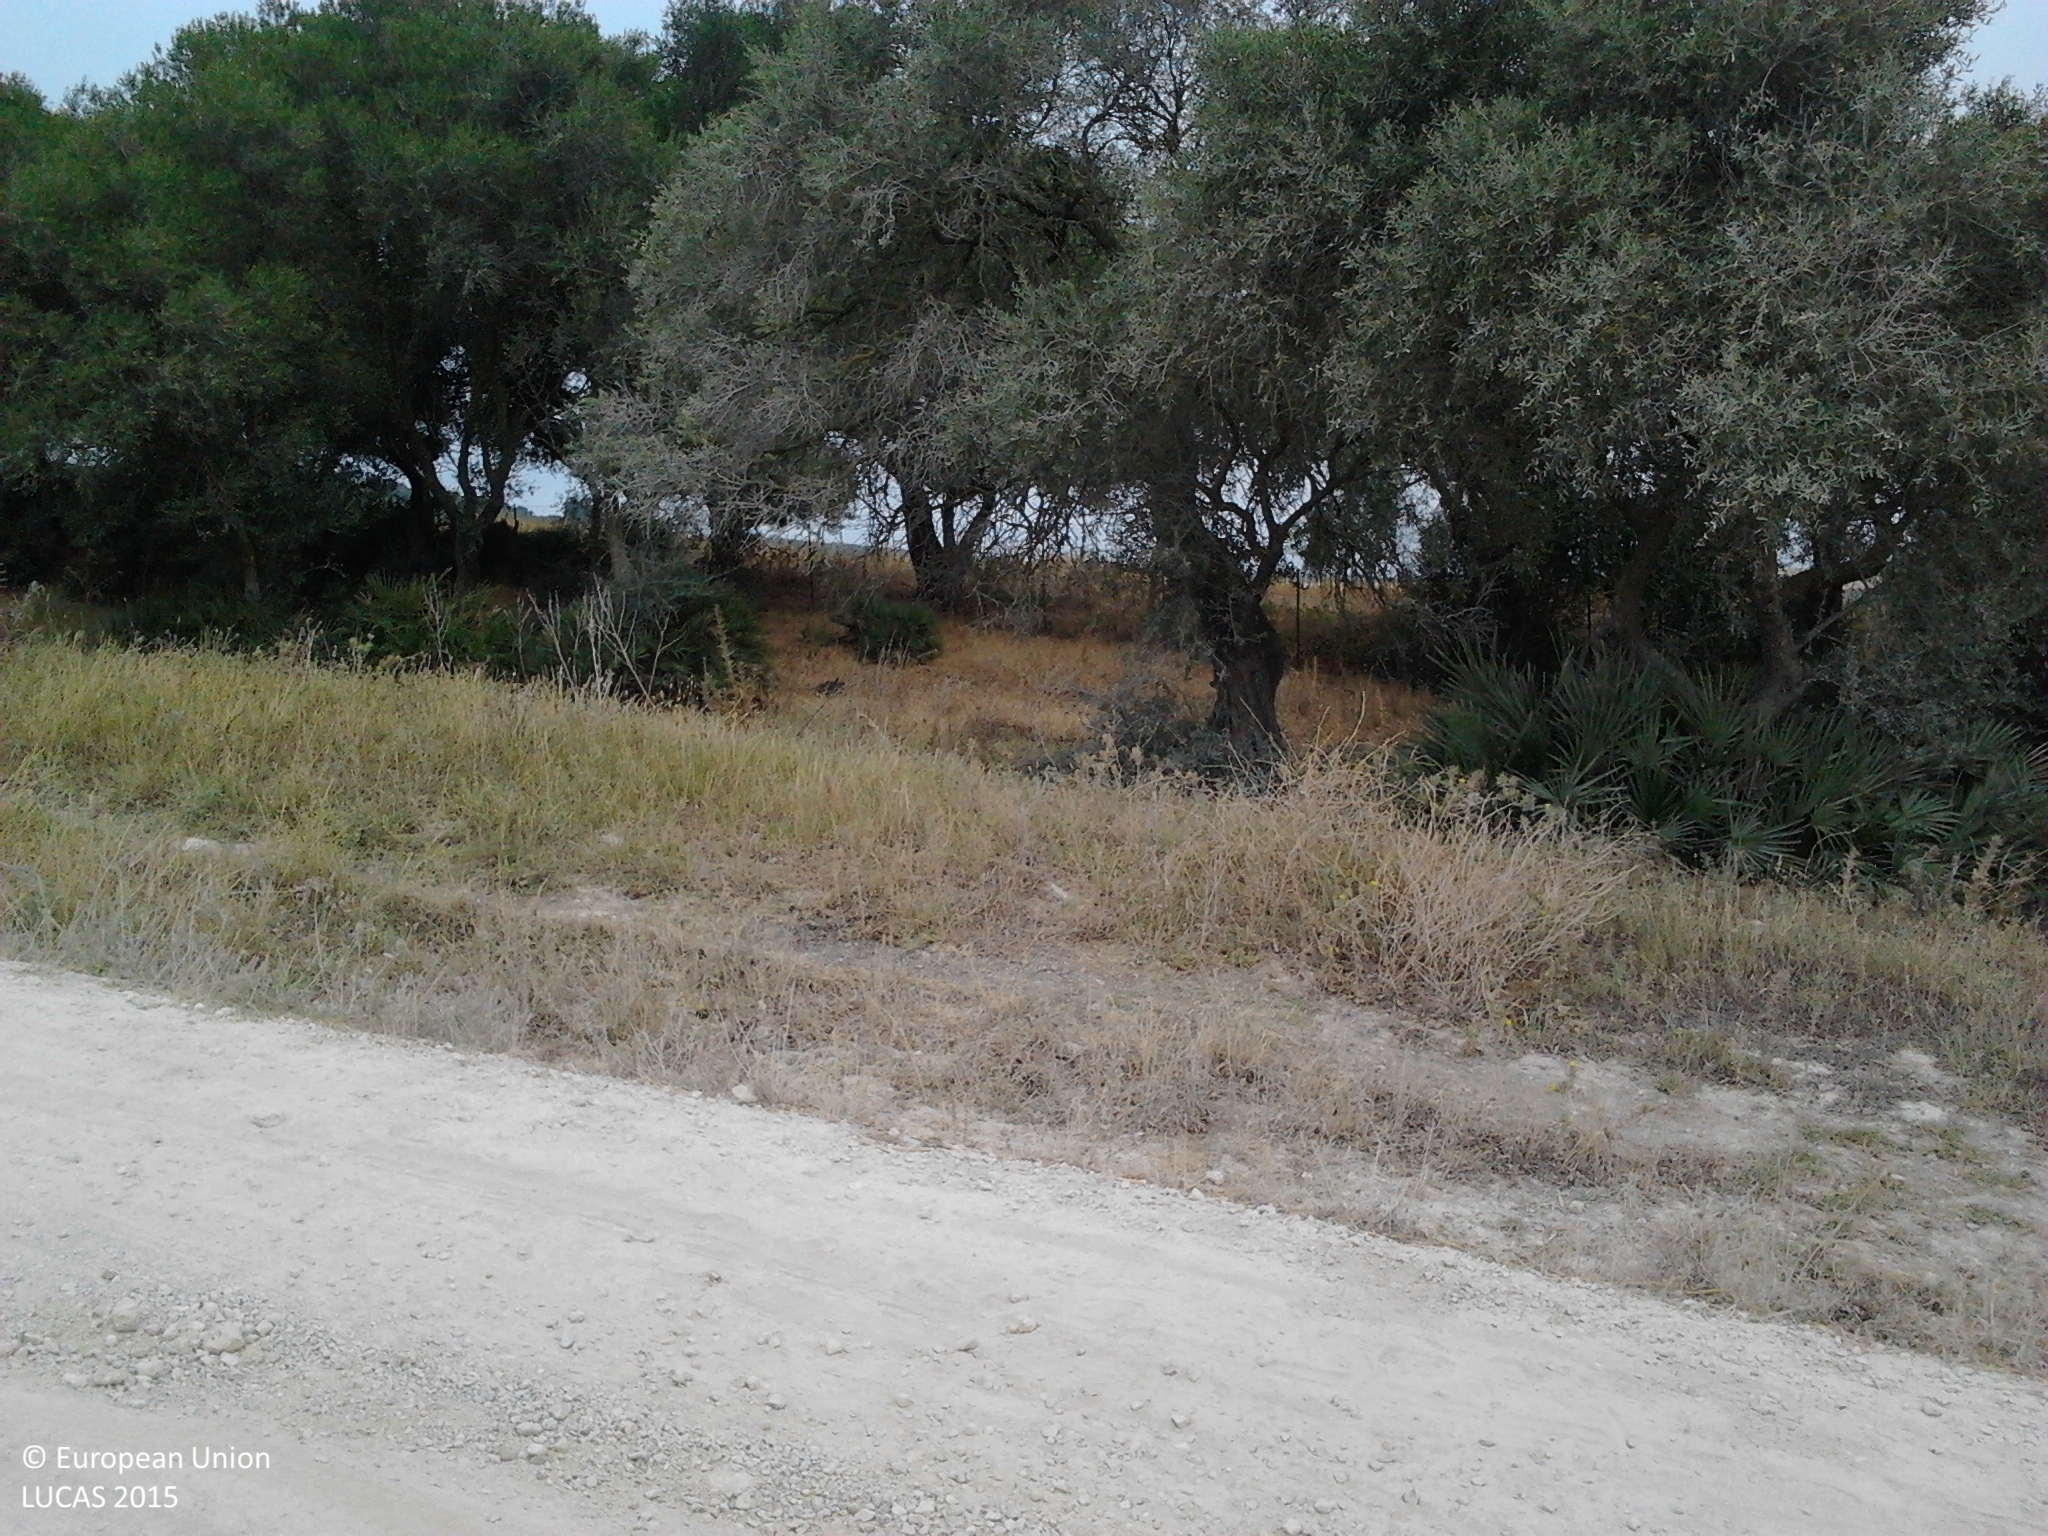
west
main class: Grassland
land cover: Grassland without tree/shrub cover
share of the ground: > 75 %
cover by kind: herbaceous plants 100 %
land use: Agriculture (excluding fallow land and kitchen gardens)
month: July
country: ES
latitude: 36.3561
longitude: -5.8363
